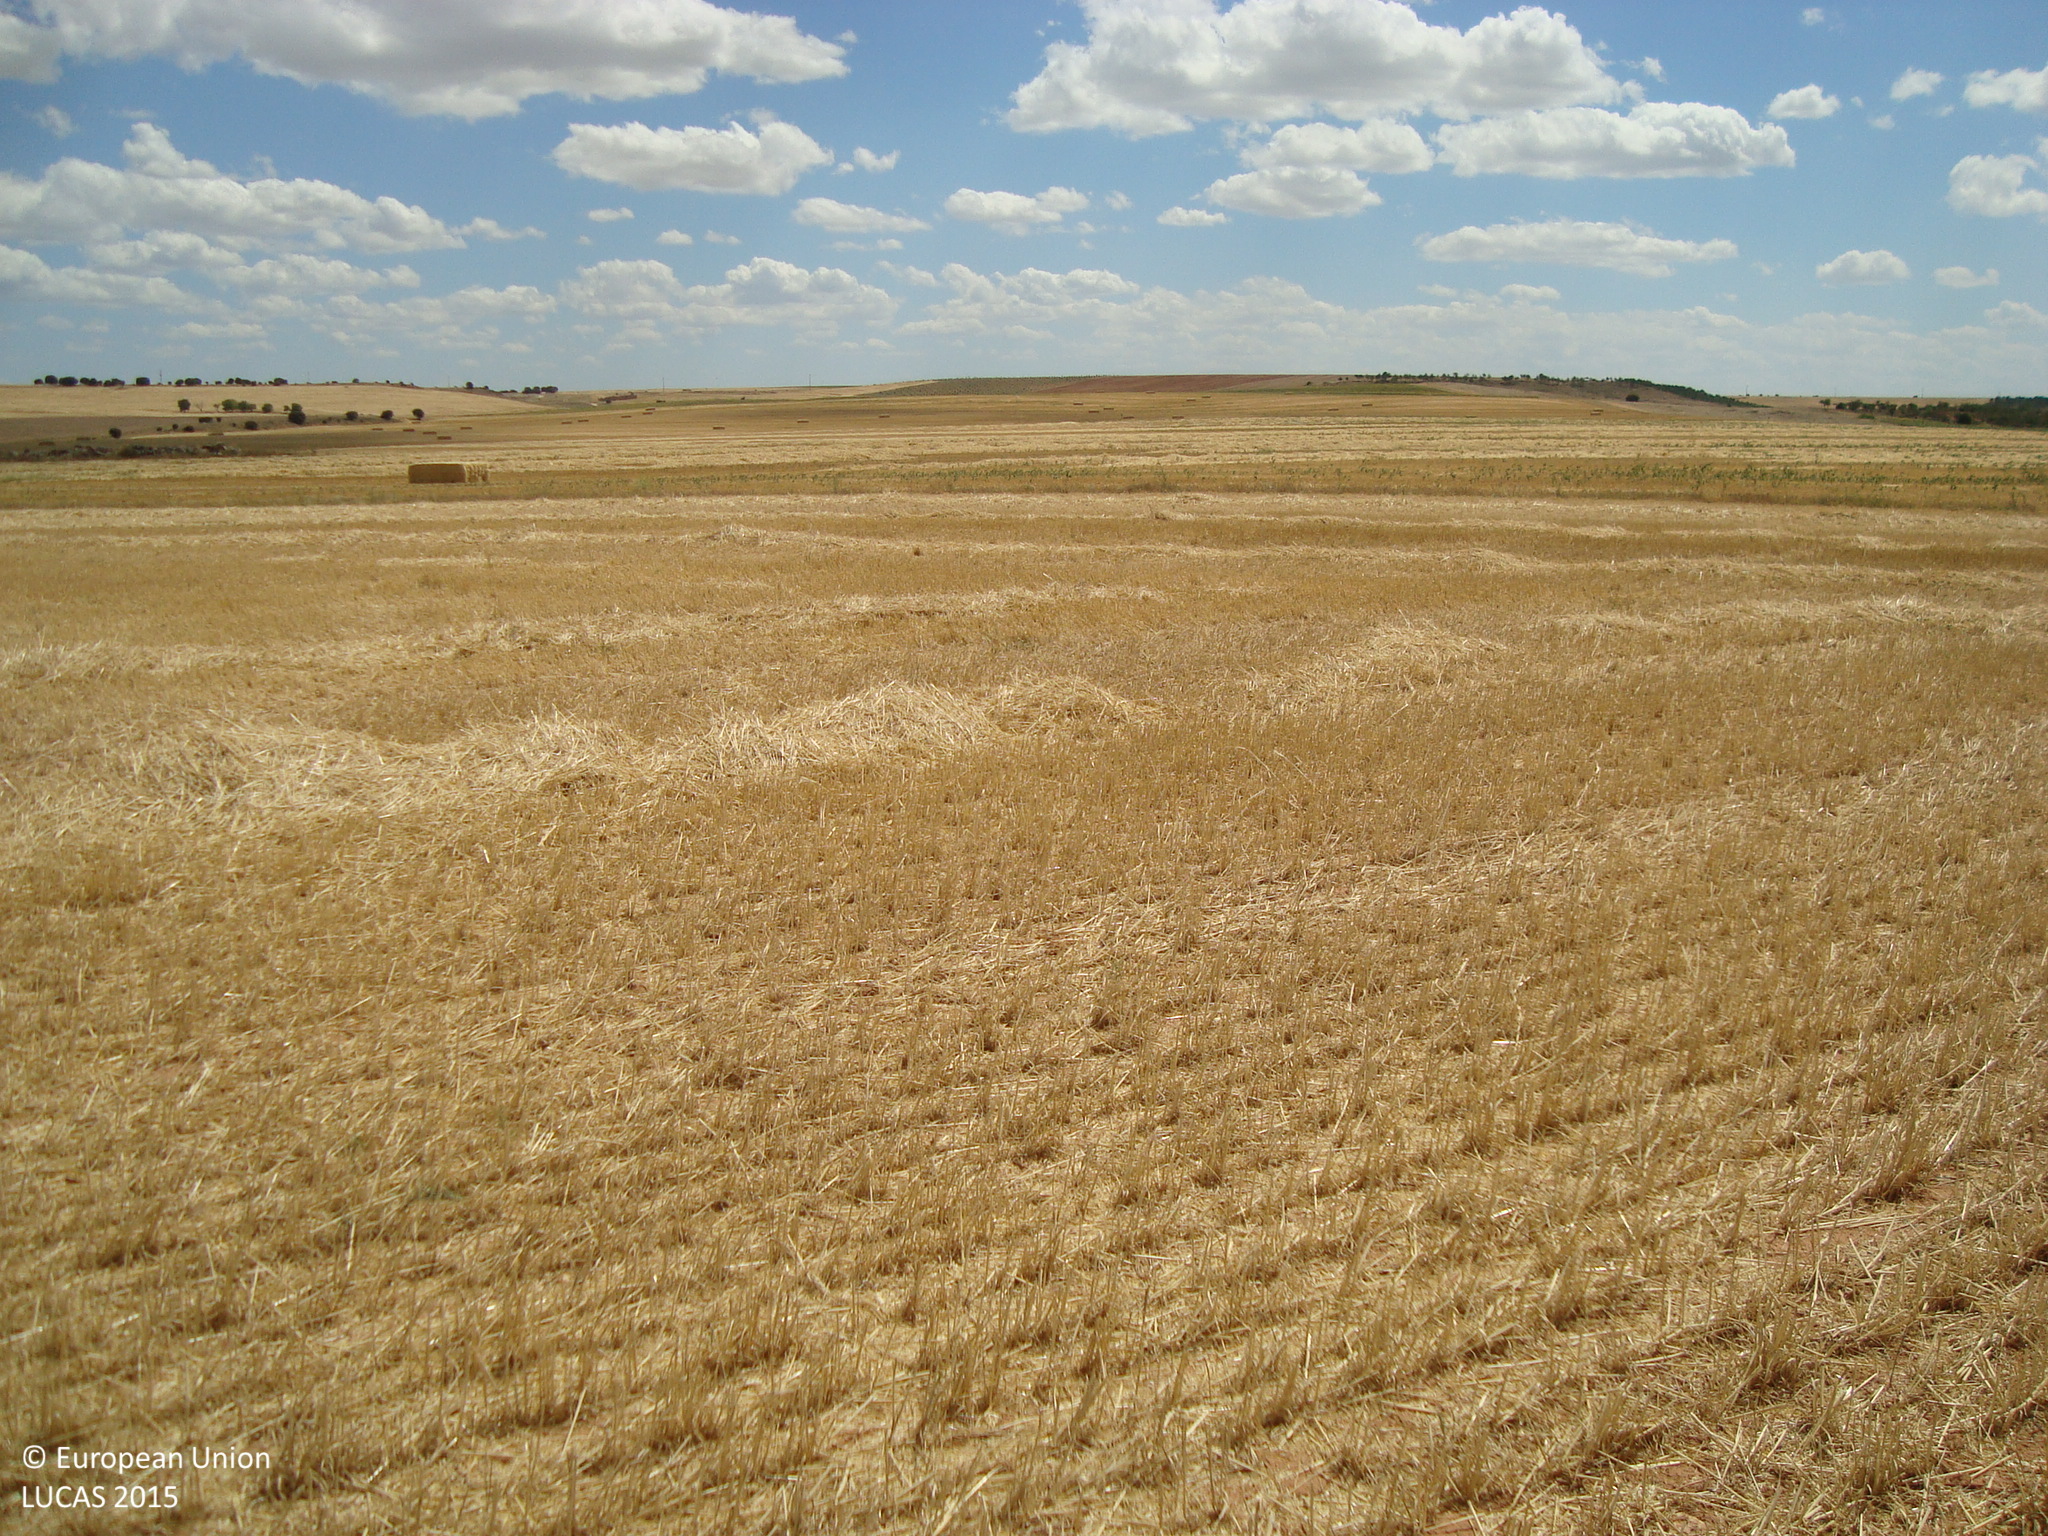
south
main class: Cropland
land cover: Common wheat
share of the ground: > 75 %
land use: Agriculture (excluding fallow land and kitchen gardens)
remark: Harvested field
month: July
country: ES
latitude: 41.9749
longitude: -3.8280
